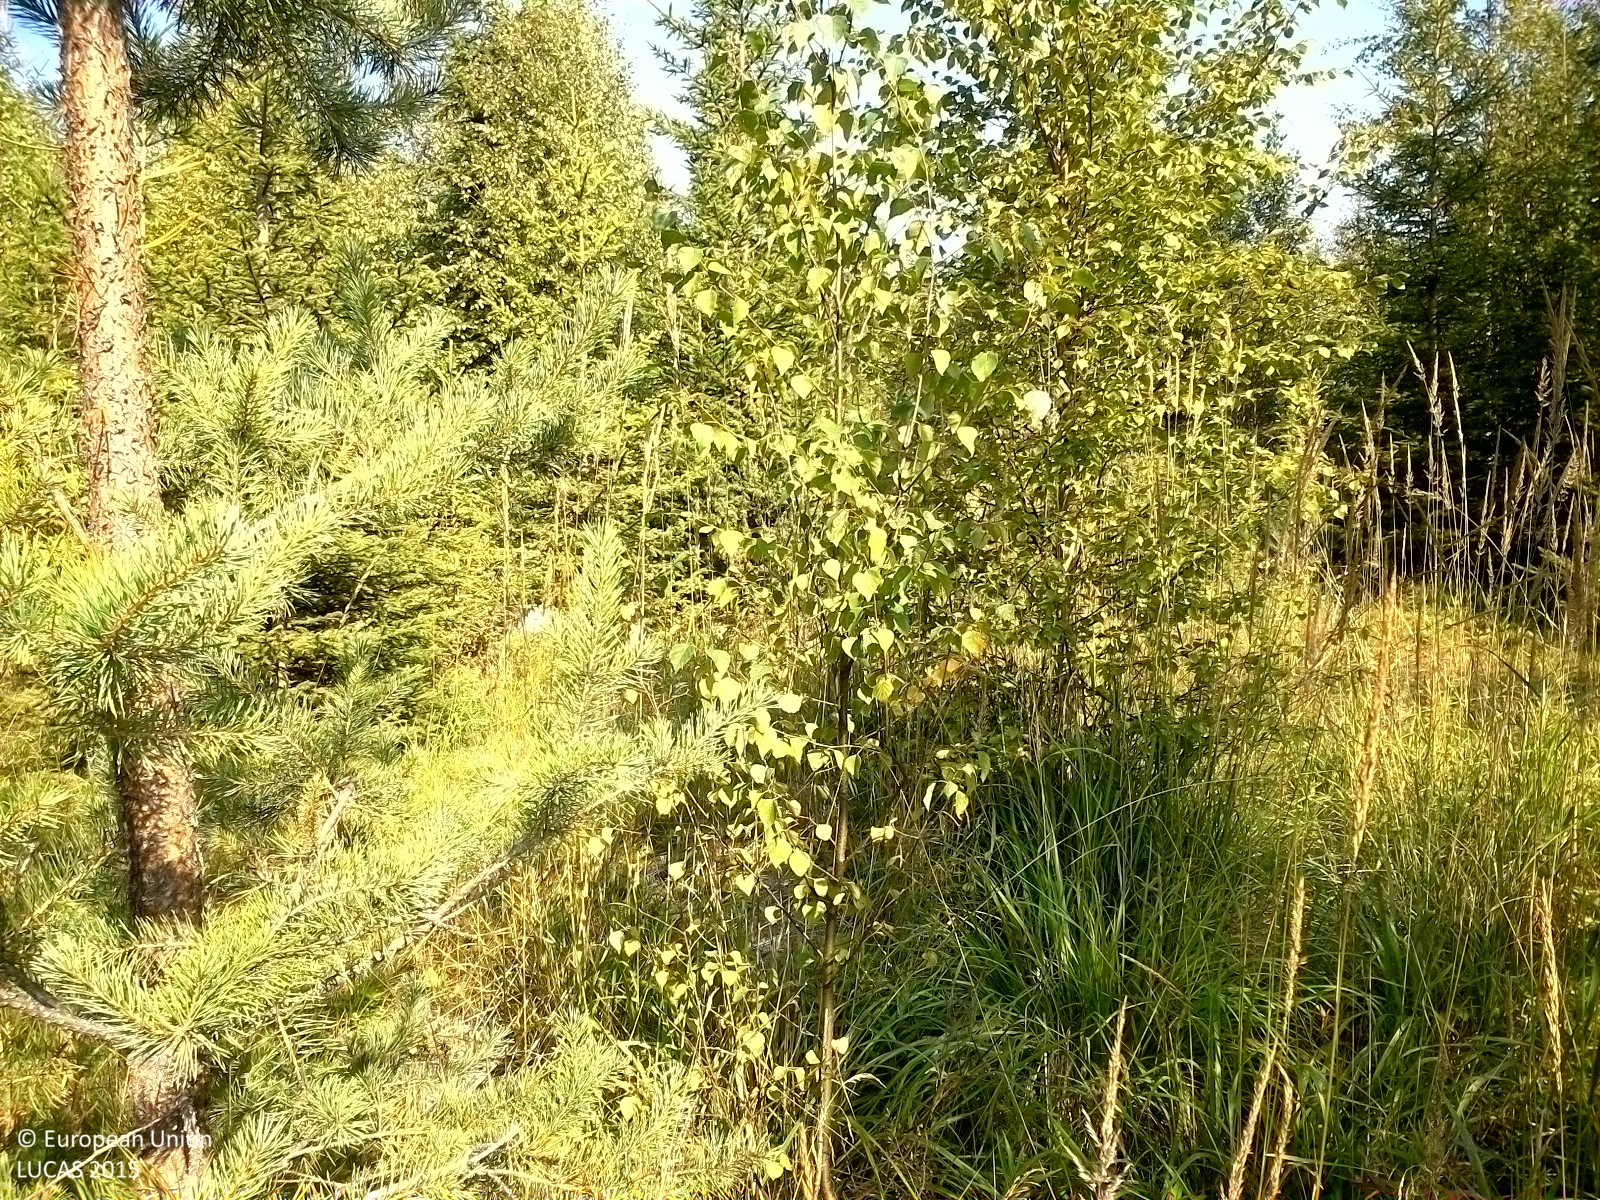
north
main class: Woodland
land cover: Other mixed woodland
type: boreal forest
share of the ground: 50 - 75 %
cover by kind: herbaceous plants 40 %, coniferous forest trees 35 %, broadleaved forest trees 20 %, shrubs 5 %
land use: Forestry
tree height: < 5 m
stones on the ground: < 10 %
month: August
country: SE
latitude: 62.4453
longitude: 16.2770
